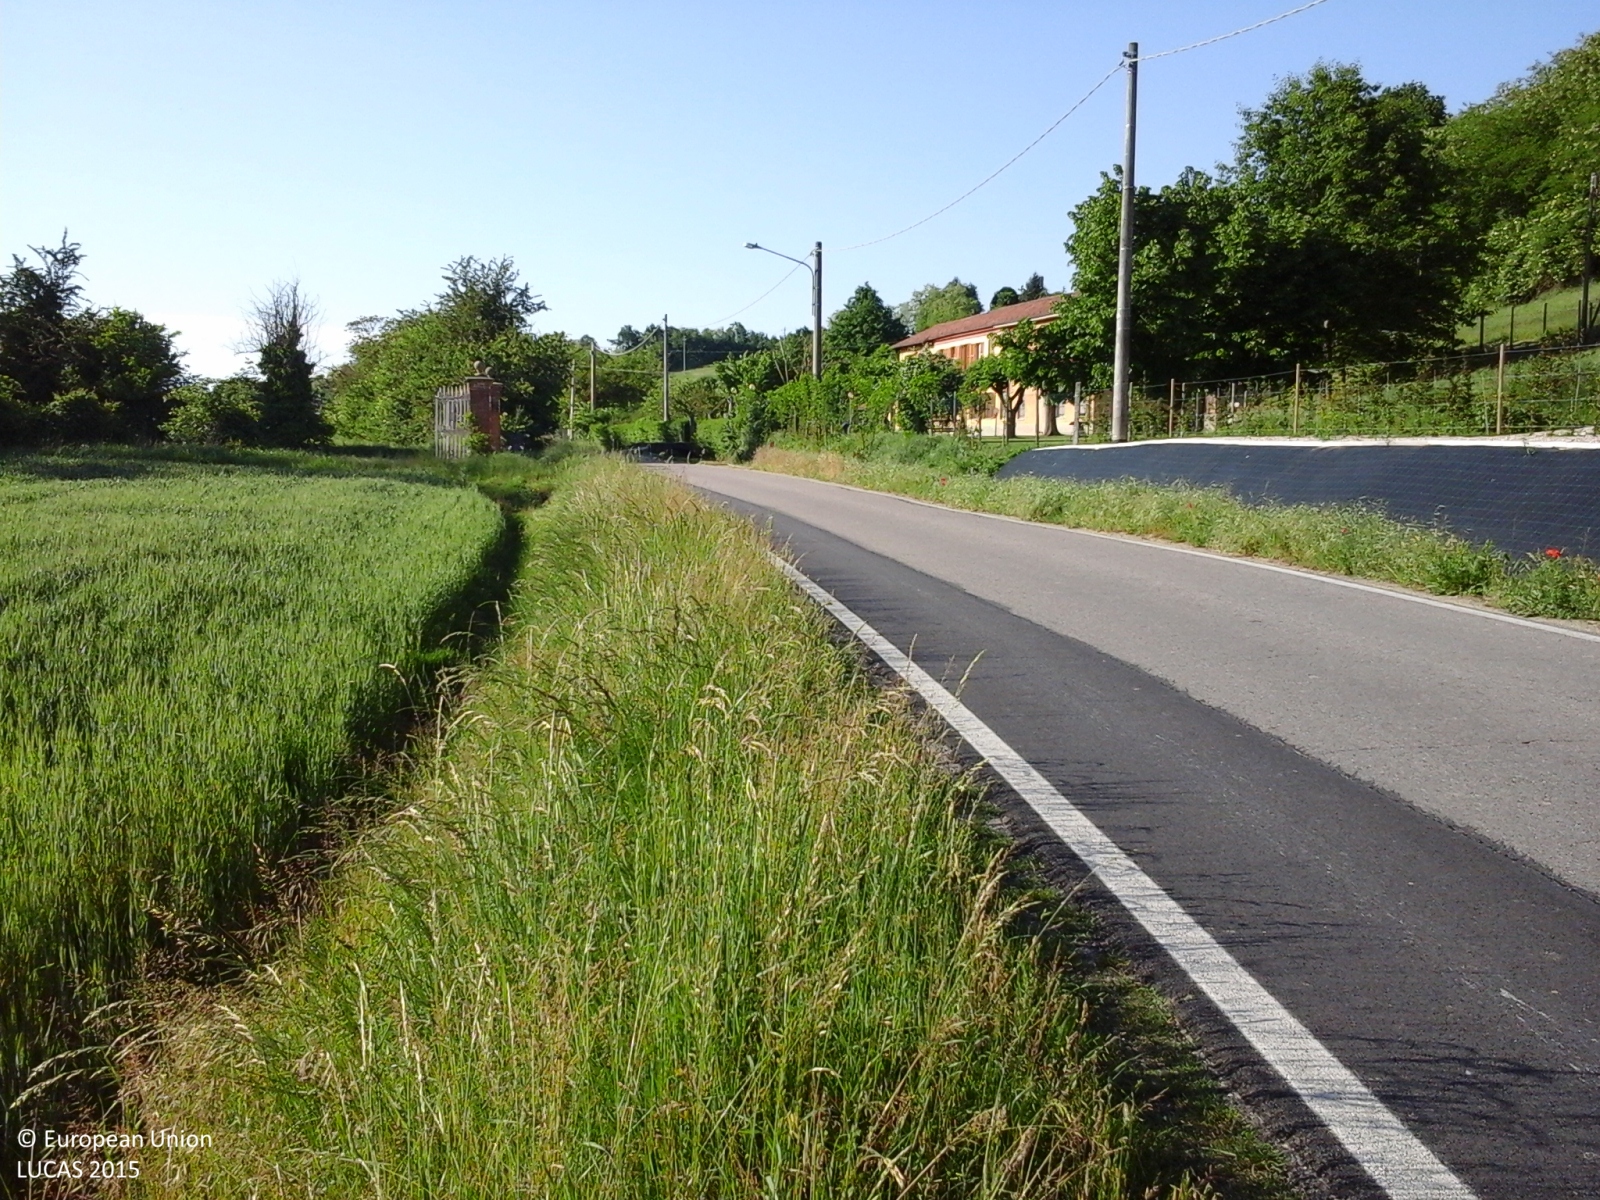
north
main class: Cropland
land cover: Common wheat
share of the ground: > 75 %
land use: Agriculture (excluding fallow land and kitchen gardens)
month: May
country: IT
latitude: 44.9305
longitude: 8.2168
